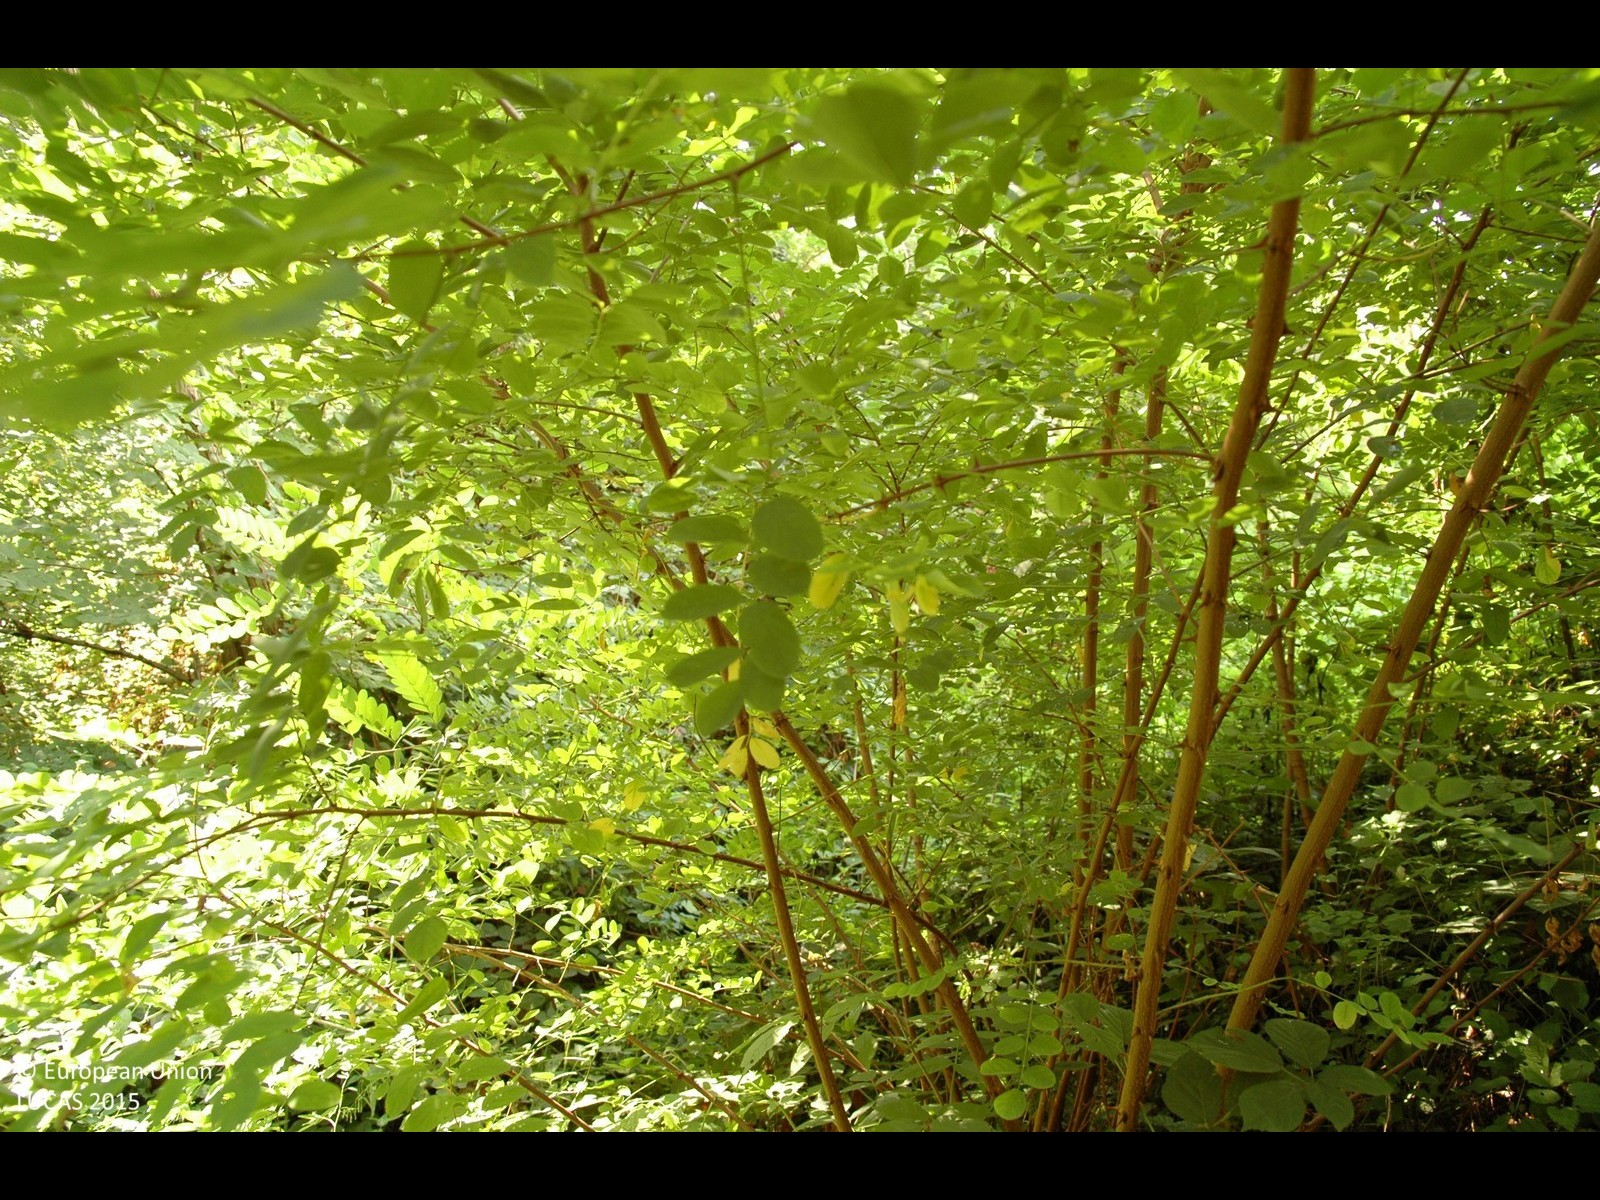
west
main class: Woodland
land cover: Broadleaved woodland
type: mesophytic deciduous forest
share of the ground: > 75 %
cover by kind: broadleaved forest trees 100 %
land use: Forestry
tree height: > 5 m
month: August
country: HR
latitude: 45.8584
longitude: 15.9870
